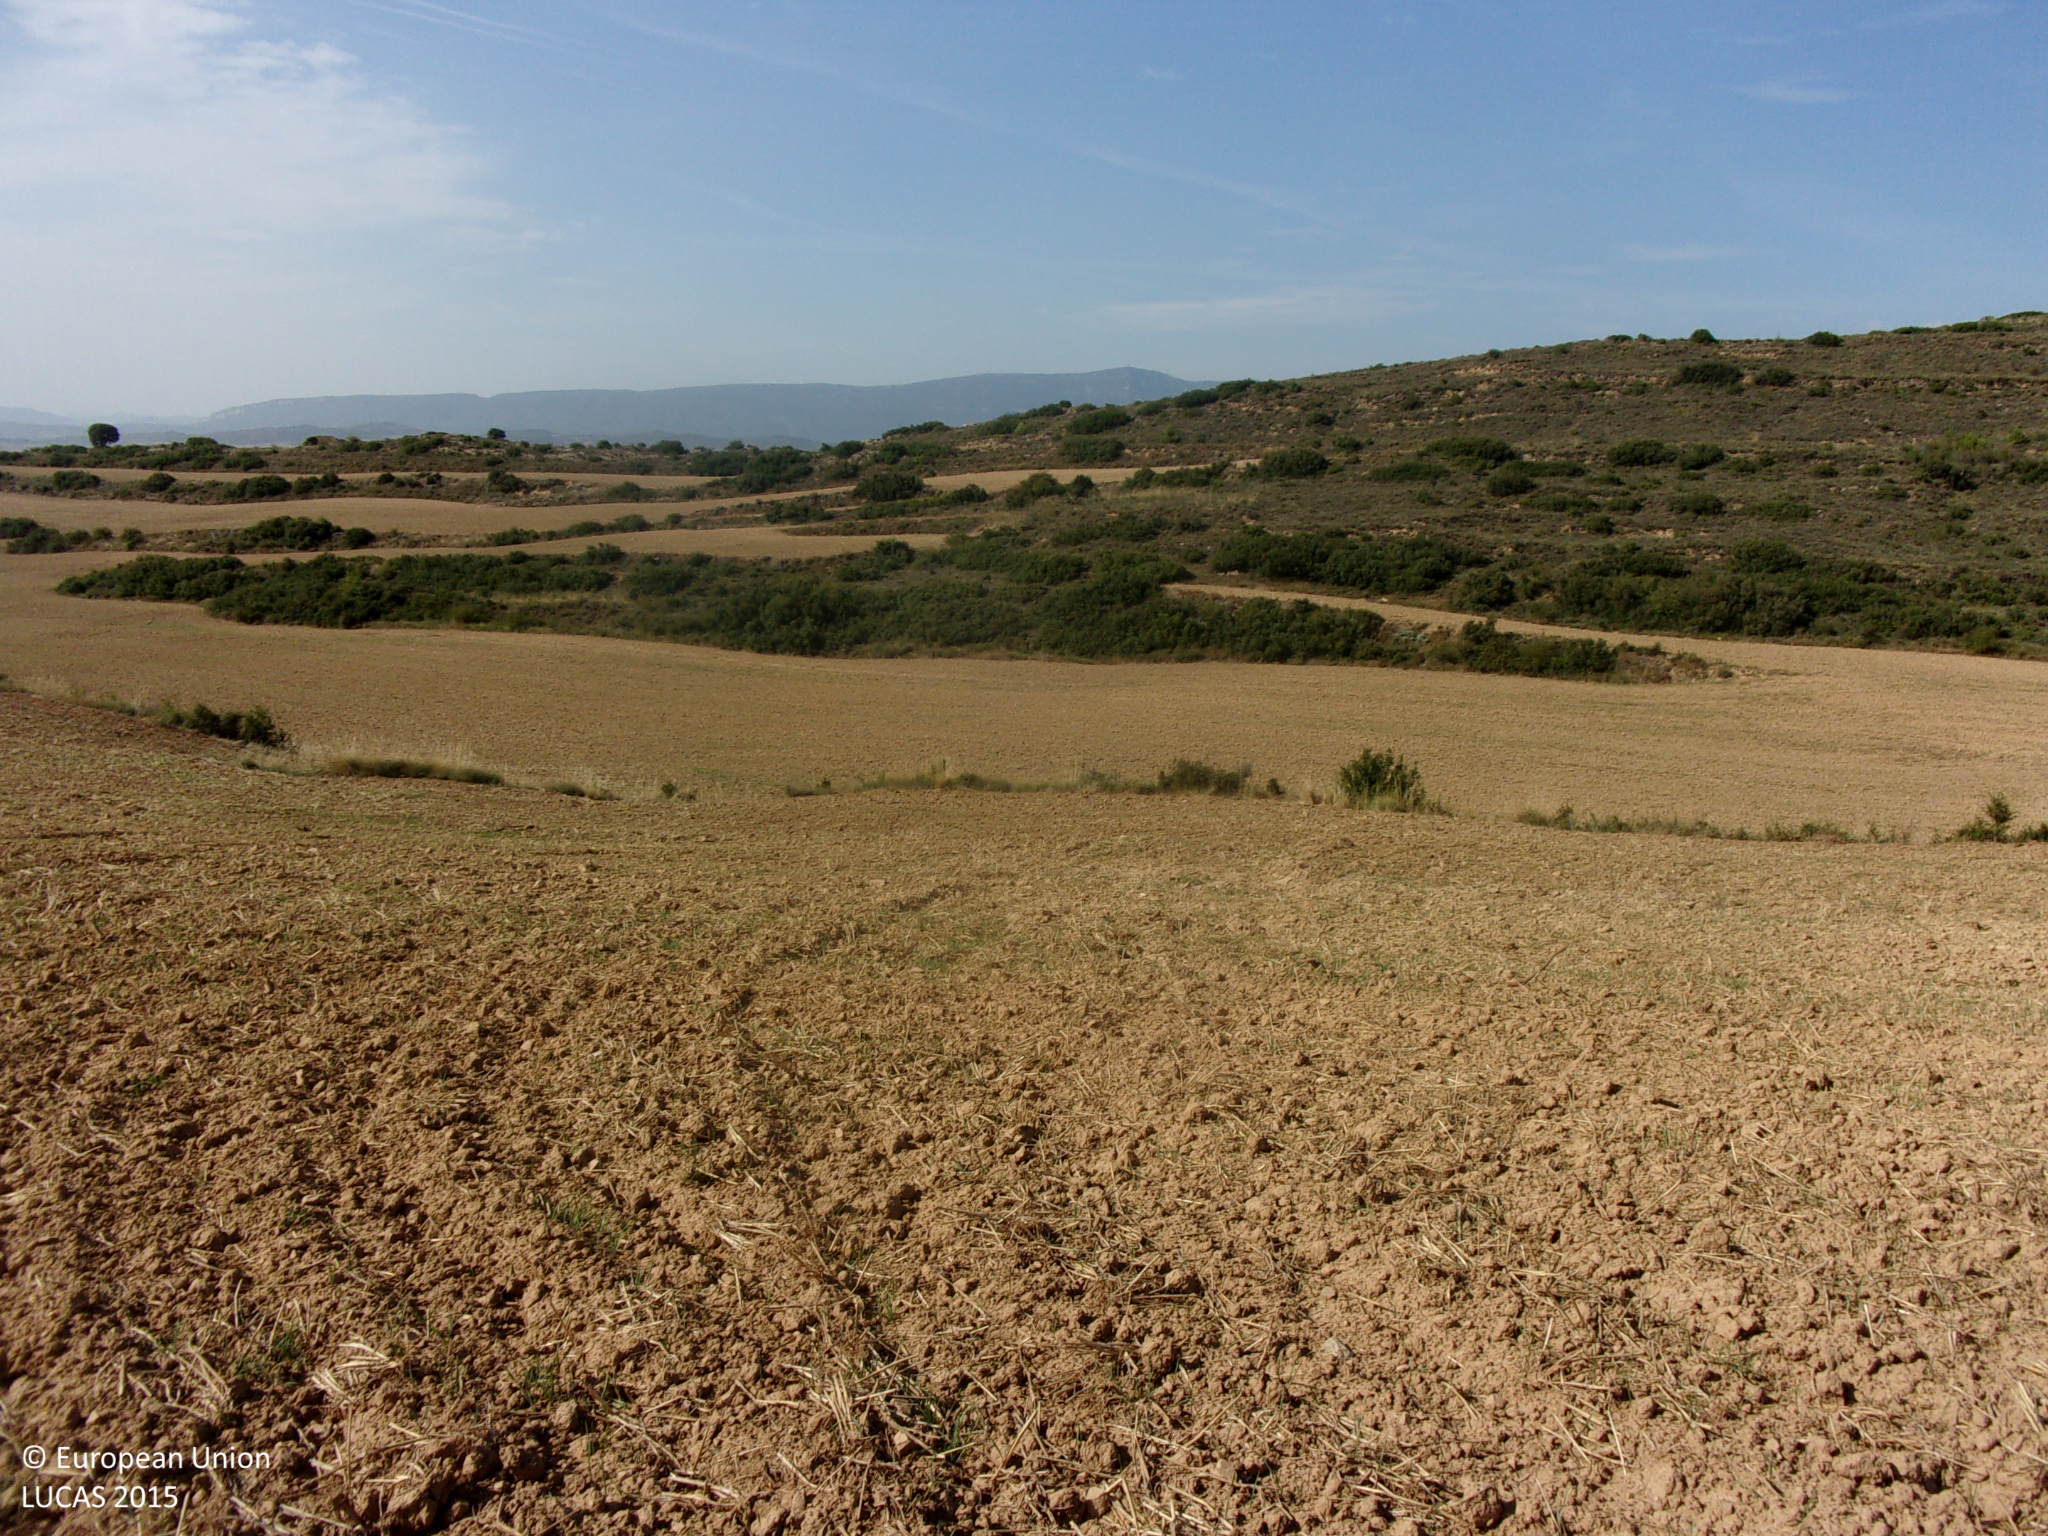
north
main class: Cropland
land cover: Common wheat
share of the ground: < 10 %
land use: Agriculture (excluding fallow land and kitchen gardens)
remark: Harvested field
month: August
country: ES
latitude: 42.5053
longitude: -1.1915
